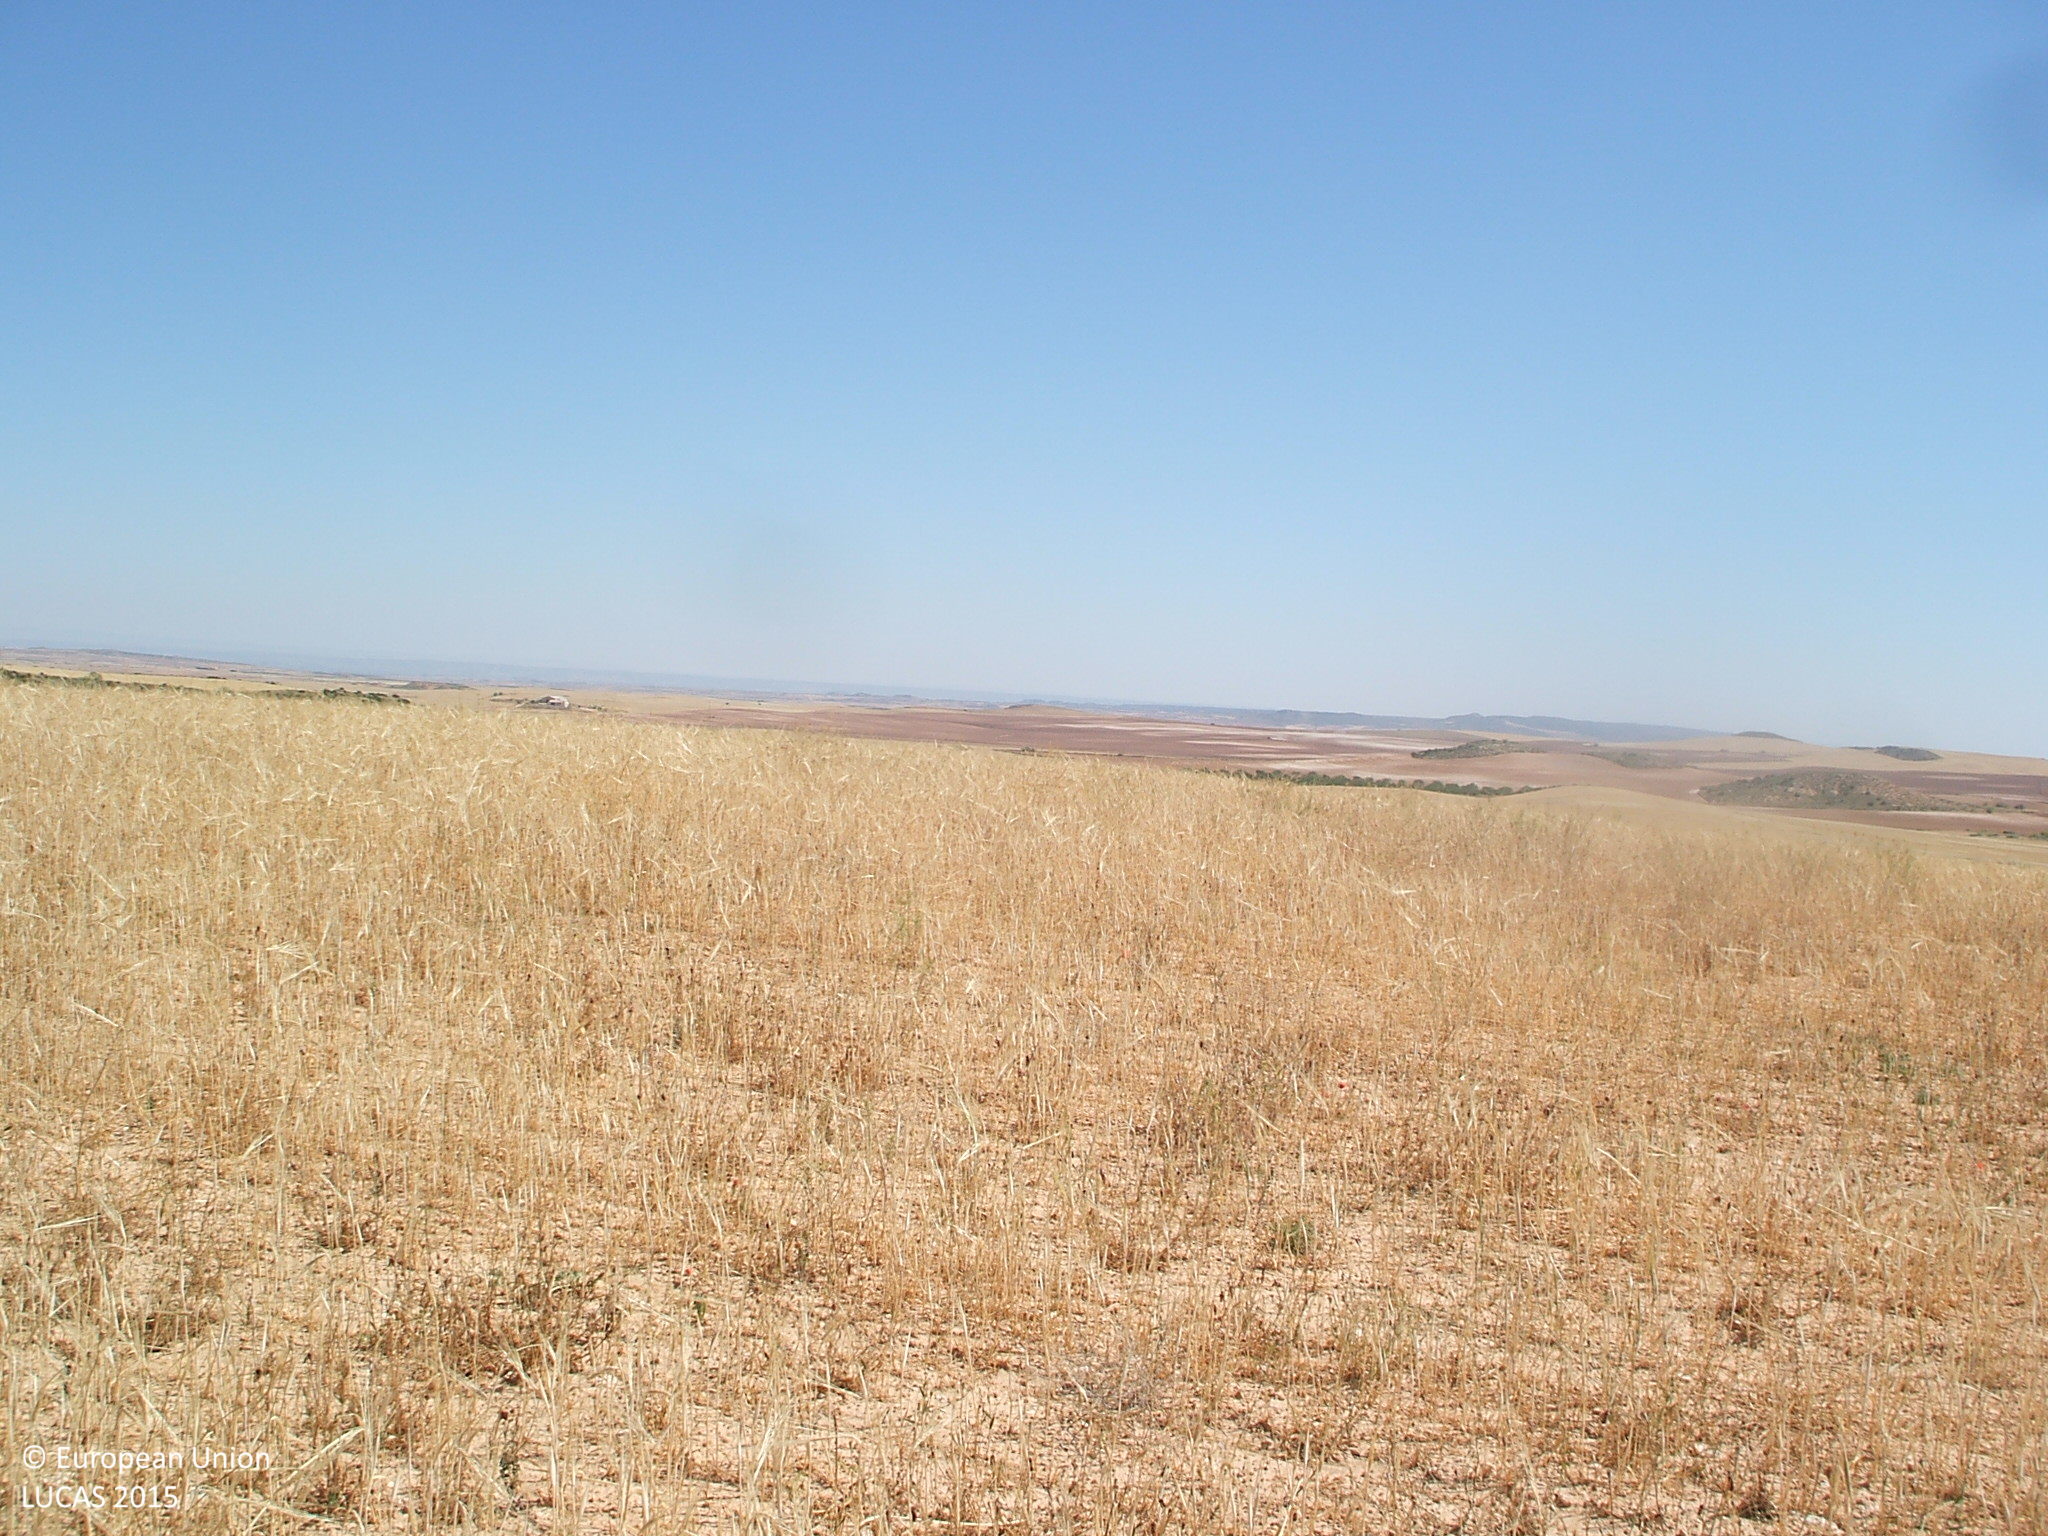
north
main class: Cropland
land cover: Barley
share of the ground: > 75 %
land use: Agriculture (excluding fallow land and kitchen gardens)
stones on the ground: > 50 %
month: June
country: ES
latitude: 41.0508
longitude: -0.3278
